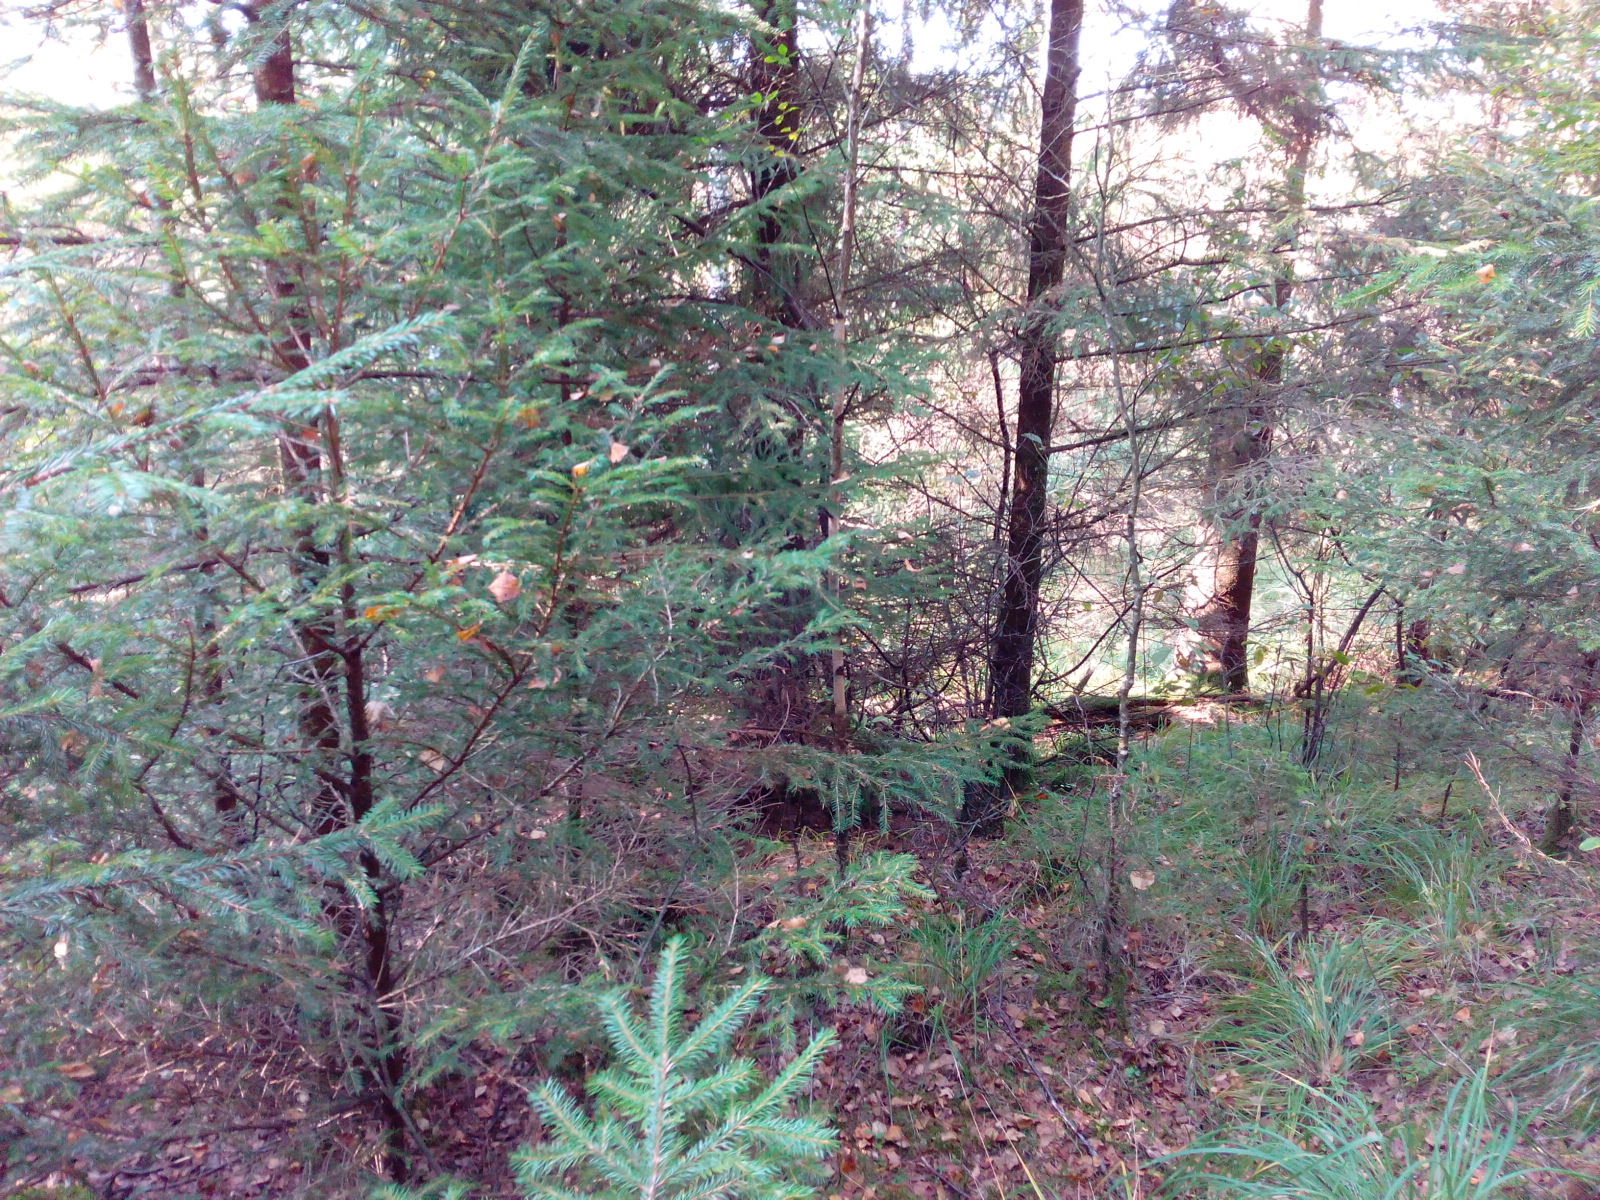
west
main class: Woodland
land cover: Other mixed woodland
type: hemiboreal forest and nemoral coniferous forest and mixed broadleaved-coniferous forest
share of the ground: > 75 %
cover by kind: coniferous forest trees 45 %, broadleaved forest trees 45 %, lichens and mosses 10 %
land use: Forestry
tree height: > 5 m
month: October
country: SE
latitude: 56.6000
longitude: 13.1080
